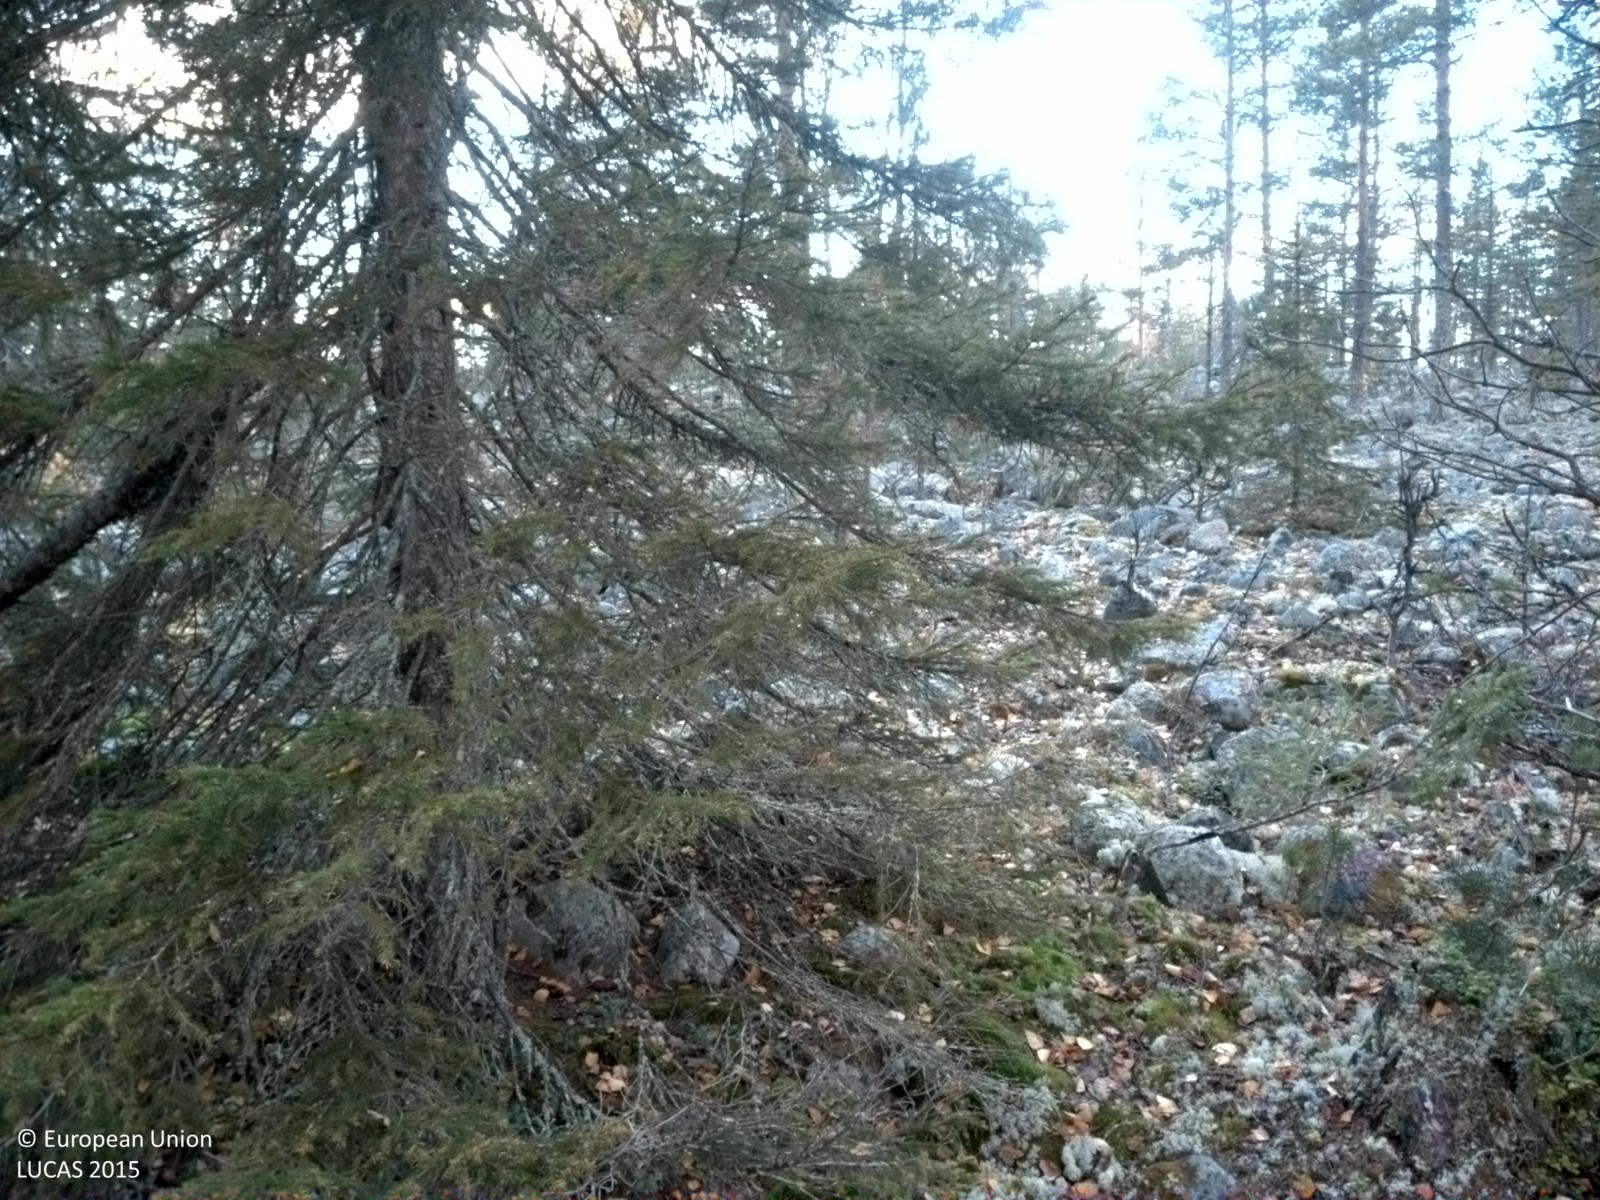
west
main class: Woodland
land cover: Pine dominated coniferous woodland
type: boreal forest
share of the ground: 25 - 50 %
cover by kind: shrubs 50 %, coniferous forest trees 30 %, lichens and mosses 10 %, consolidated bare surface 10 %
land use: Forestry
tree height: > 5 m
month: October
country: SE
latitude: 65.9891
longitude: 22.0649
